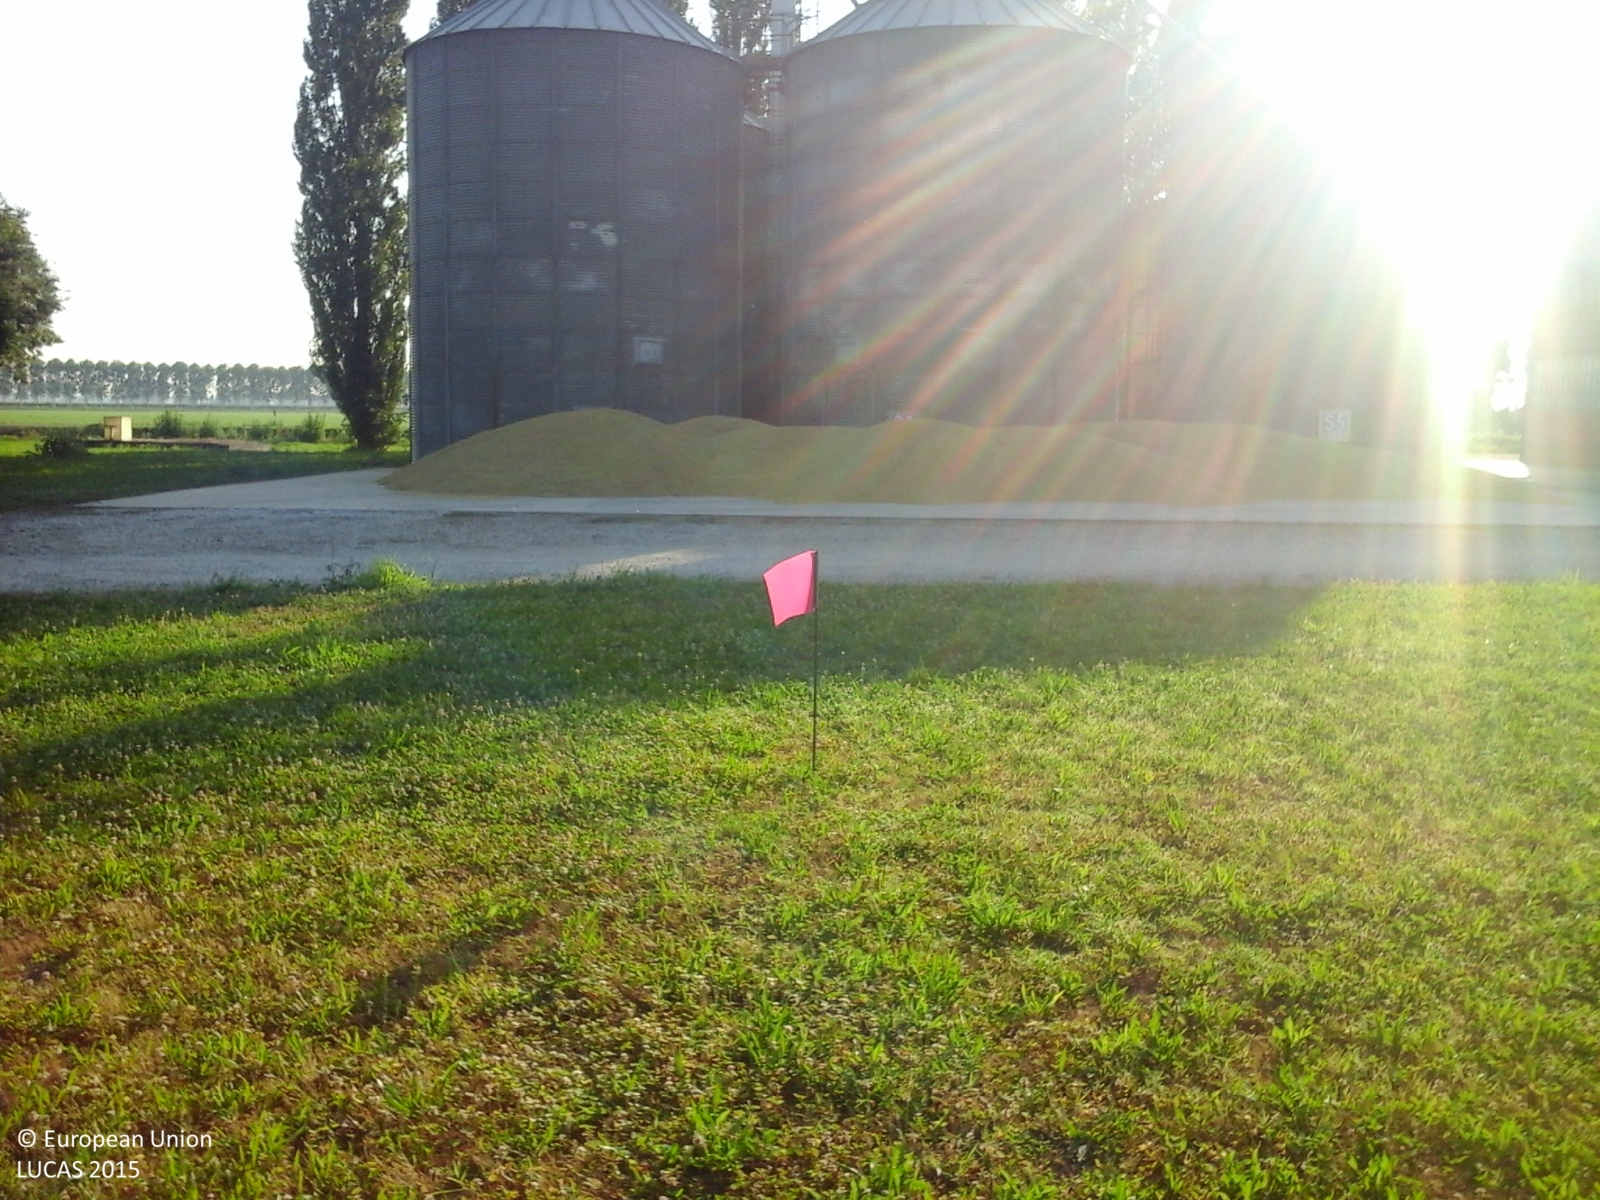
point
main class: Grassland
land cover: Grassland without tree/shrub cover
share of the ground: > 75 %
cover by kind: herbaceous plants 100 %
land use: Agriculture (excluding fallow land and kitchen gardens)
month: June
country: IT
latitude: 44.6073
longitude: 11.6975
